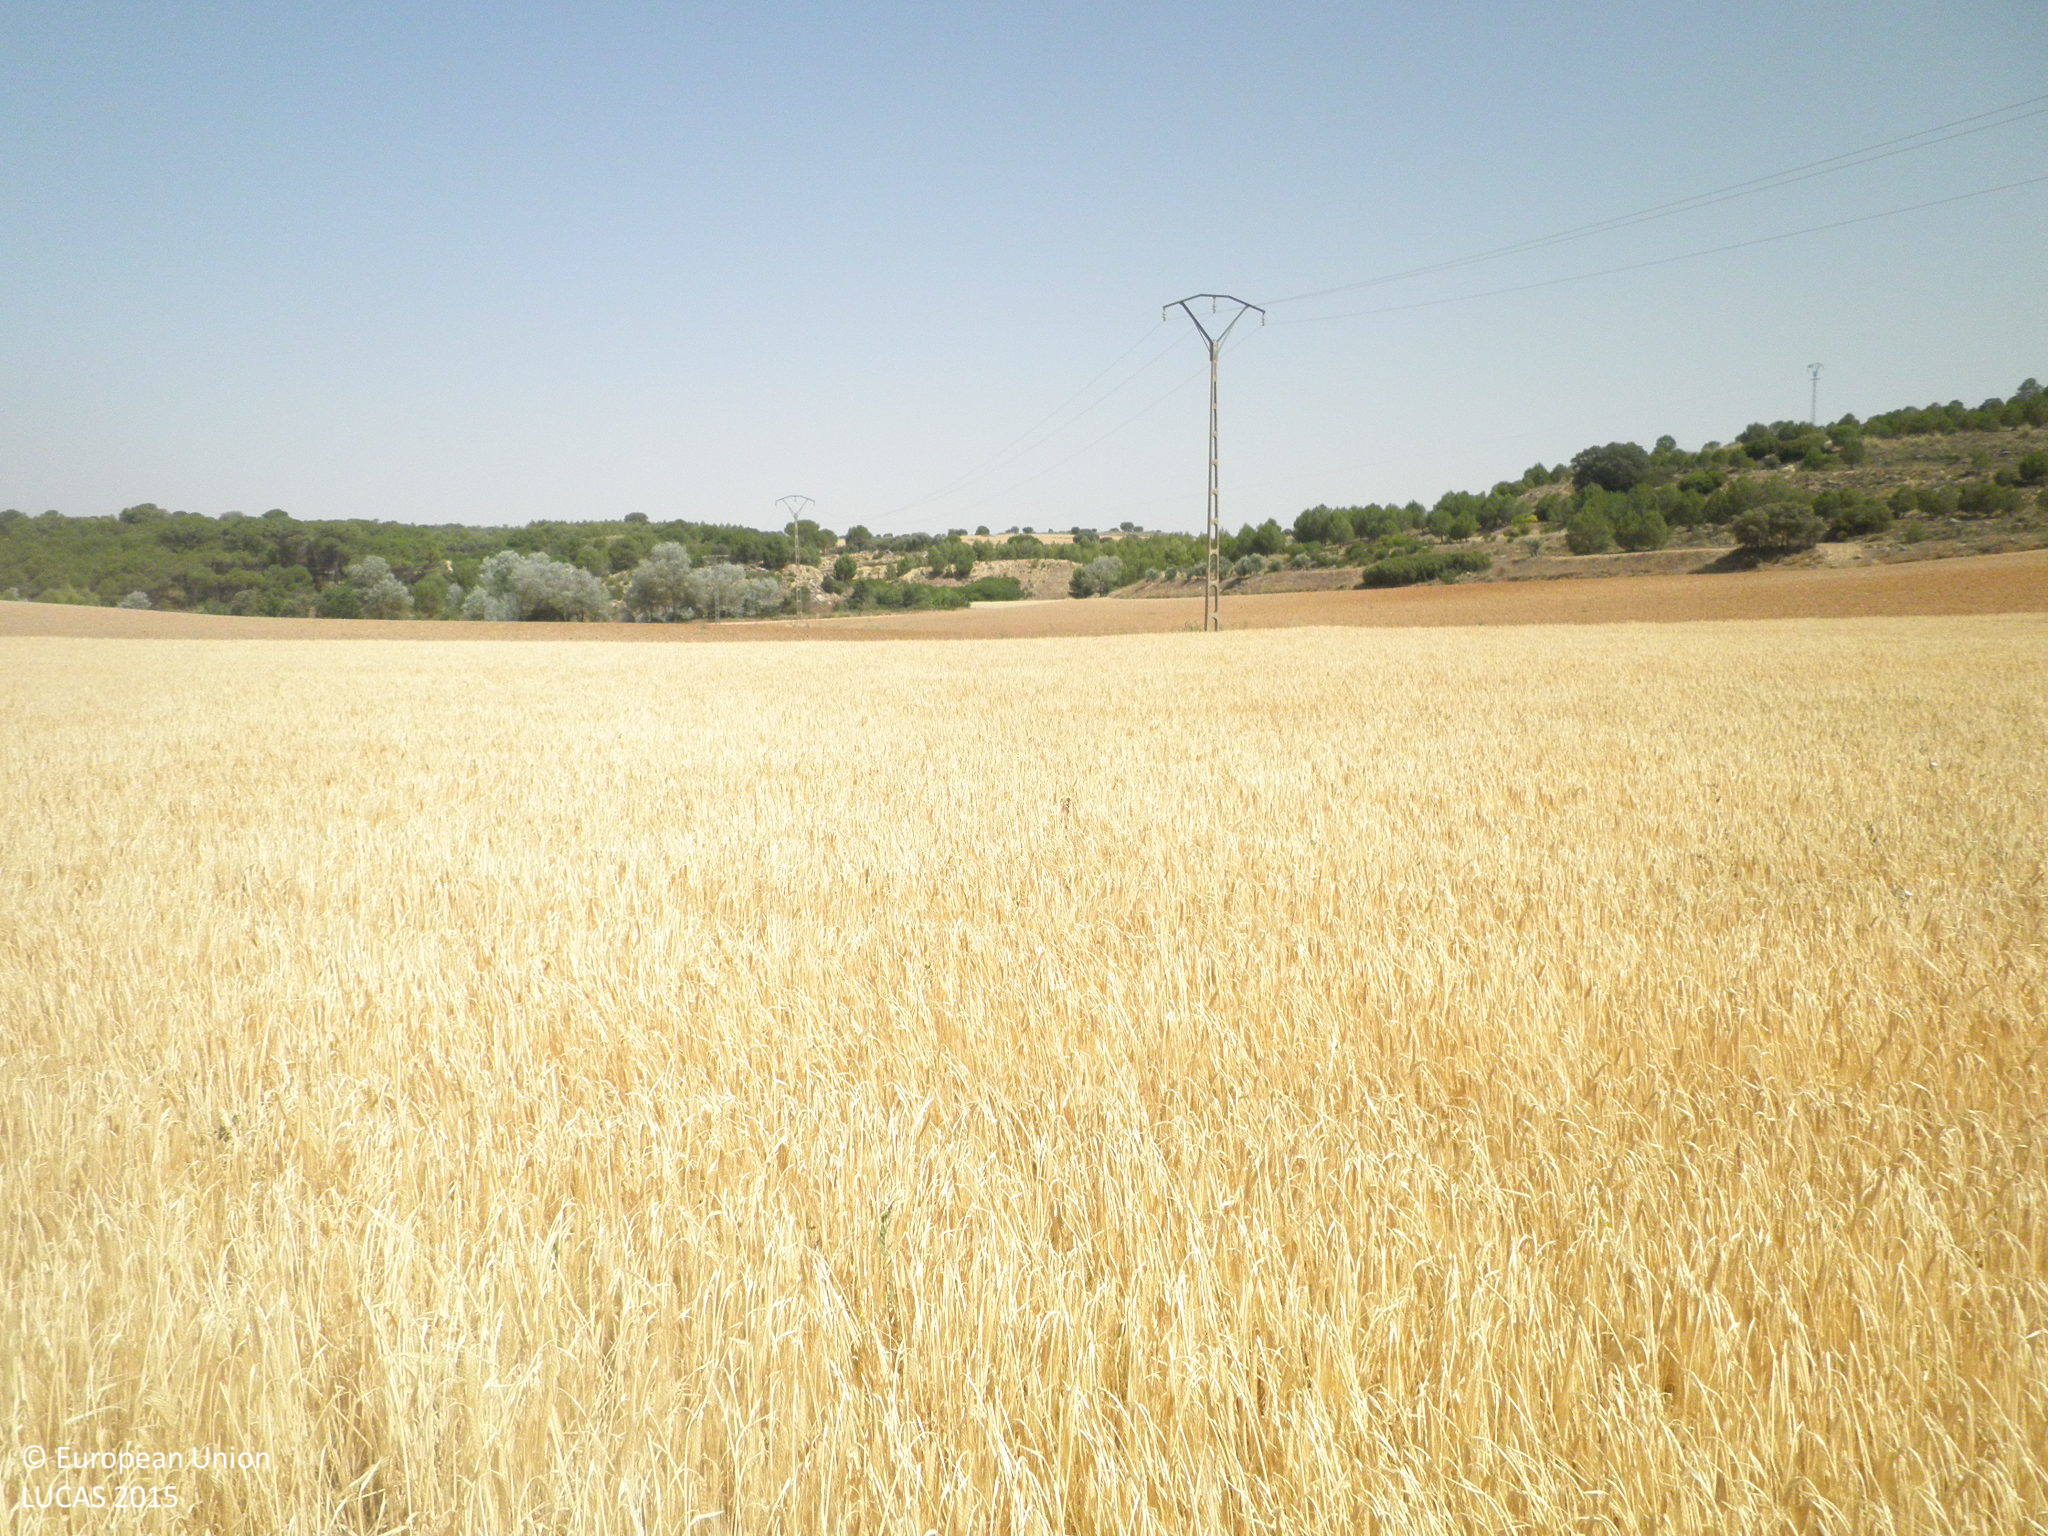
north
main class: Cropland
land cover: Barley
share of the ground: > 75 %
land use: Agriculture (excluding fallow land and kitchen gardens)
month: July
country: ES
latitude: 39.5706
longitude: -2.6681
